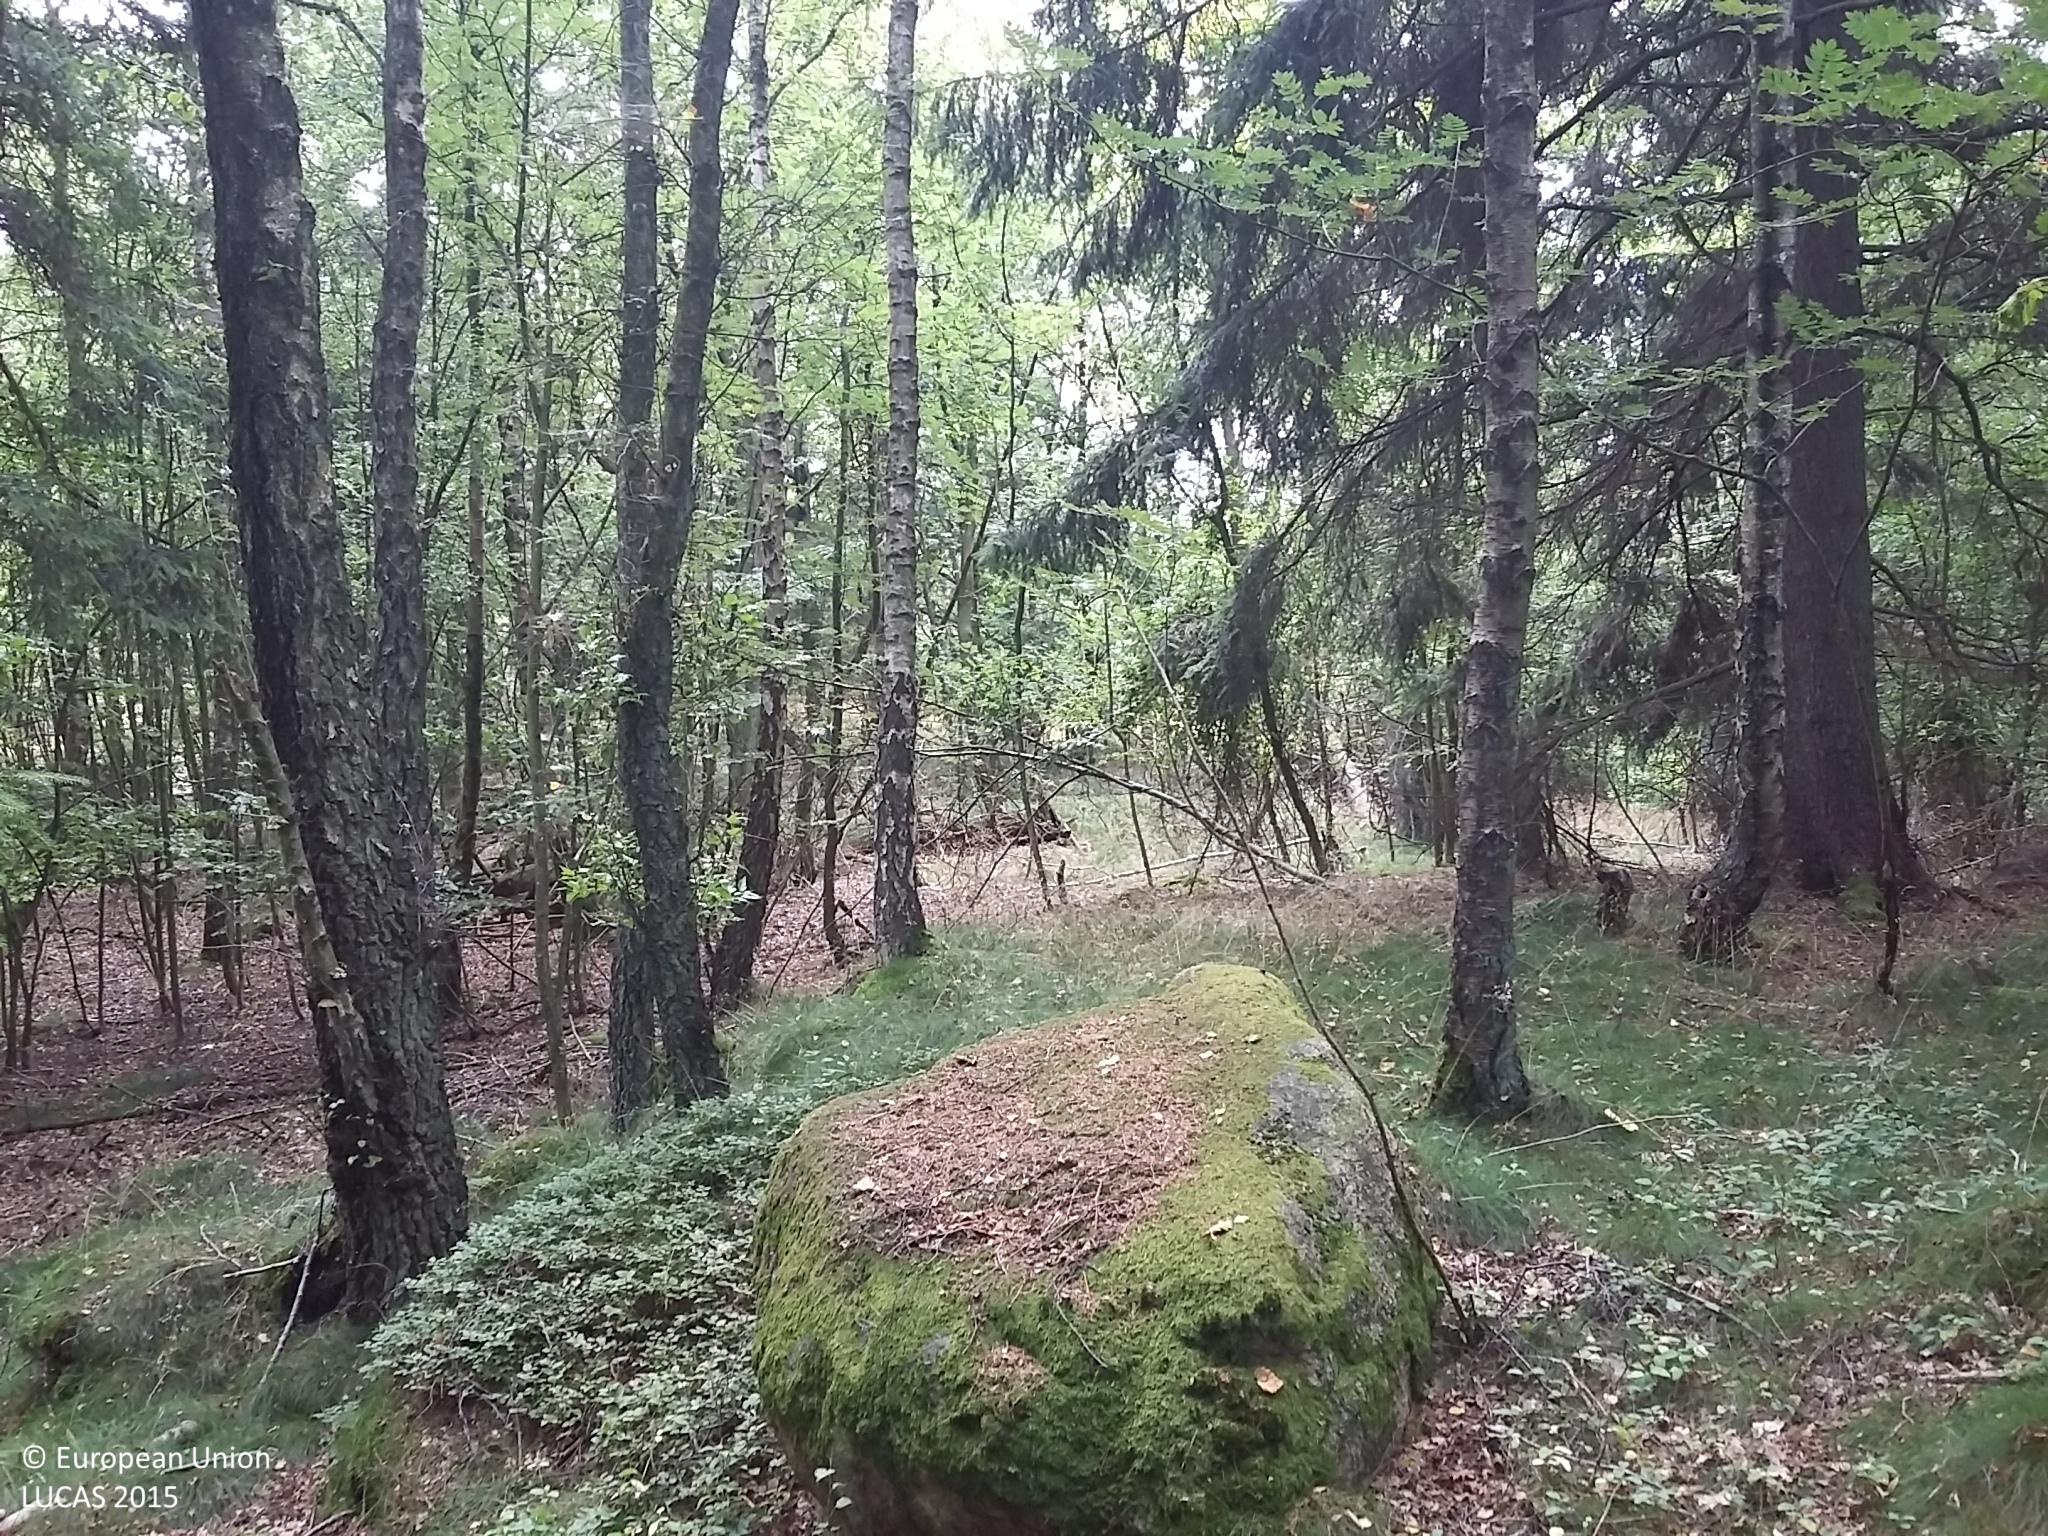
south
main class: Woodland
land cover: Other mixed woodland
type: hemiboreal forest and nemoral coniferous forest and mixed broadleaved-coniferous forest
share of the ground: > 75 %
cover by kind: coniferous forest trees 60 %, broadleaved forest trees 25 %, herbaceous plants 10 %, lichens and mosses 5 %
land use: Semi-natural and natural areas not in use
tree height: > 5 m
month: August
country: DK
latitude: 55.2529
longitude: 14.7667
